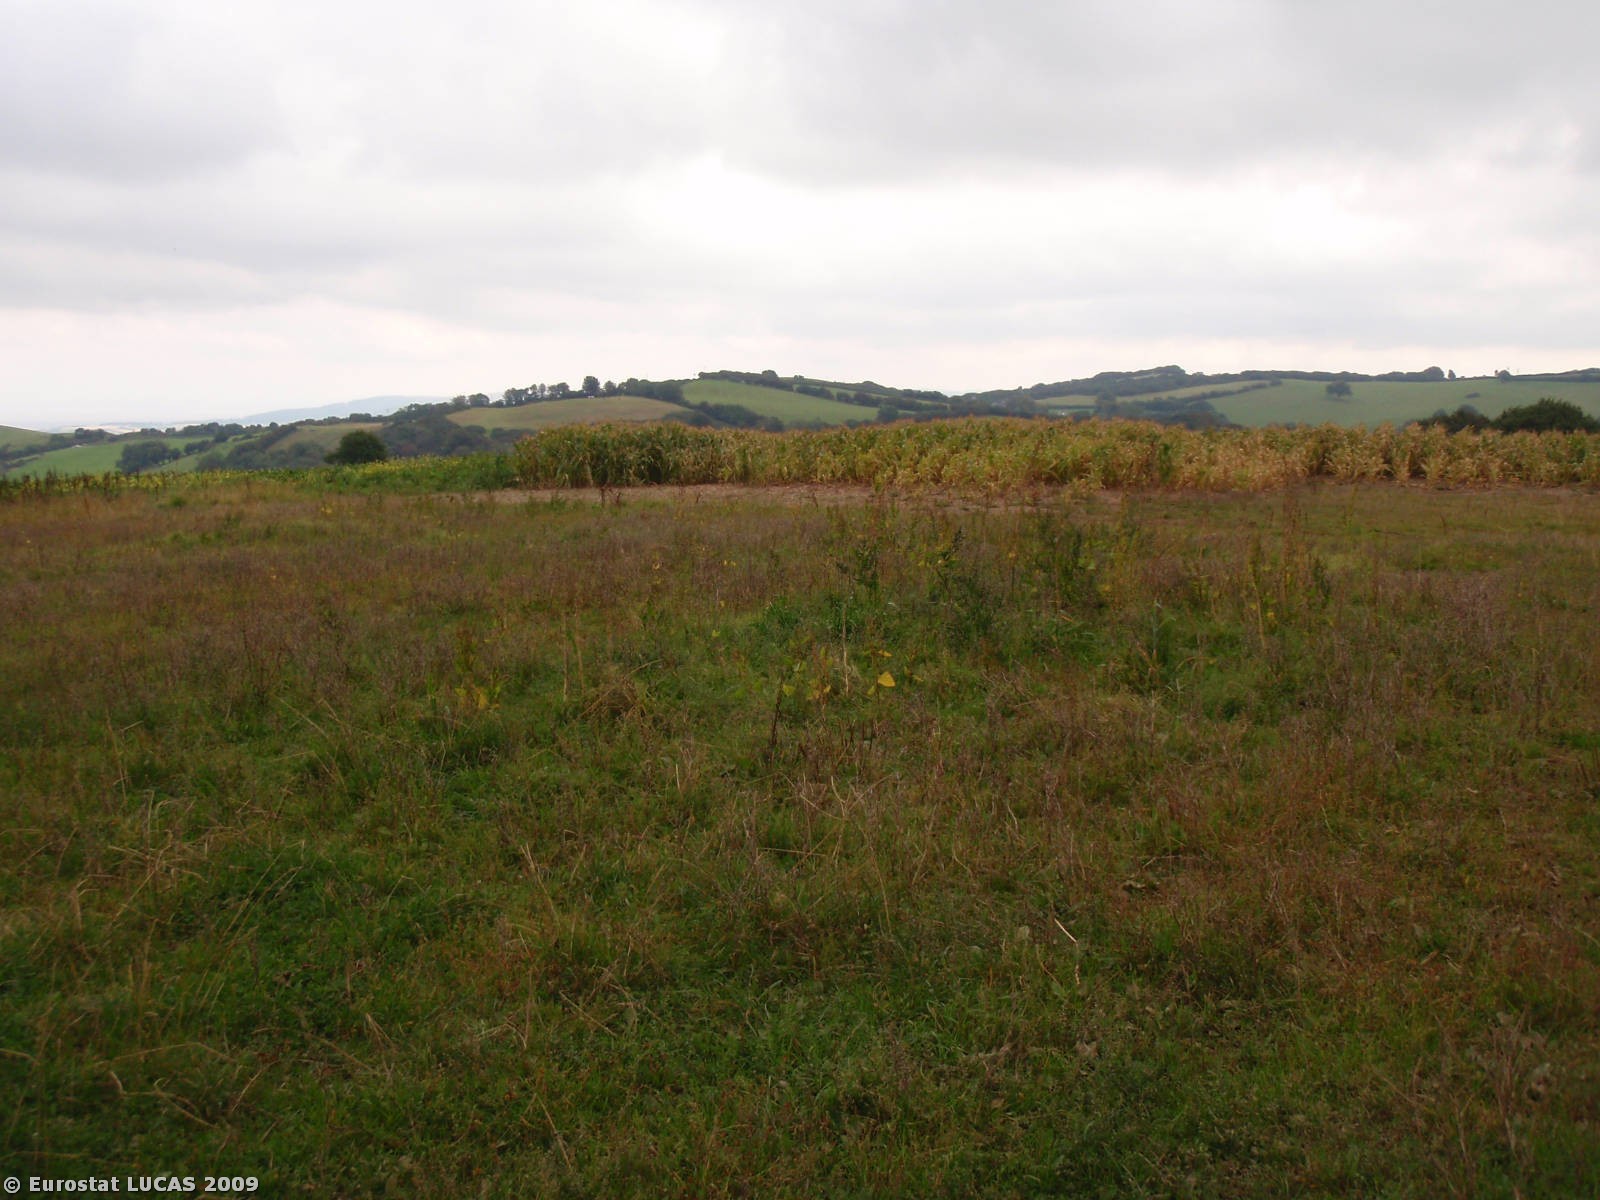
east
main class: Grassland
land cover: Grassland without tree/shrub cover
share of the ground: 50 - 75 %
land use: Agriculture (excluding fallow land and kitchen gardens)
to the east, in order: Grassland without tree/shrub cover; Maize; Rape and turnip rape; Spontaneously vegetated surfaces; Abandoned hedges; Arable land (only in case pi)
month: September
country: GB
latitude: 51.1162
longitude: -3.4401
